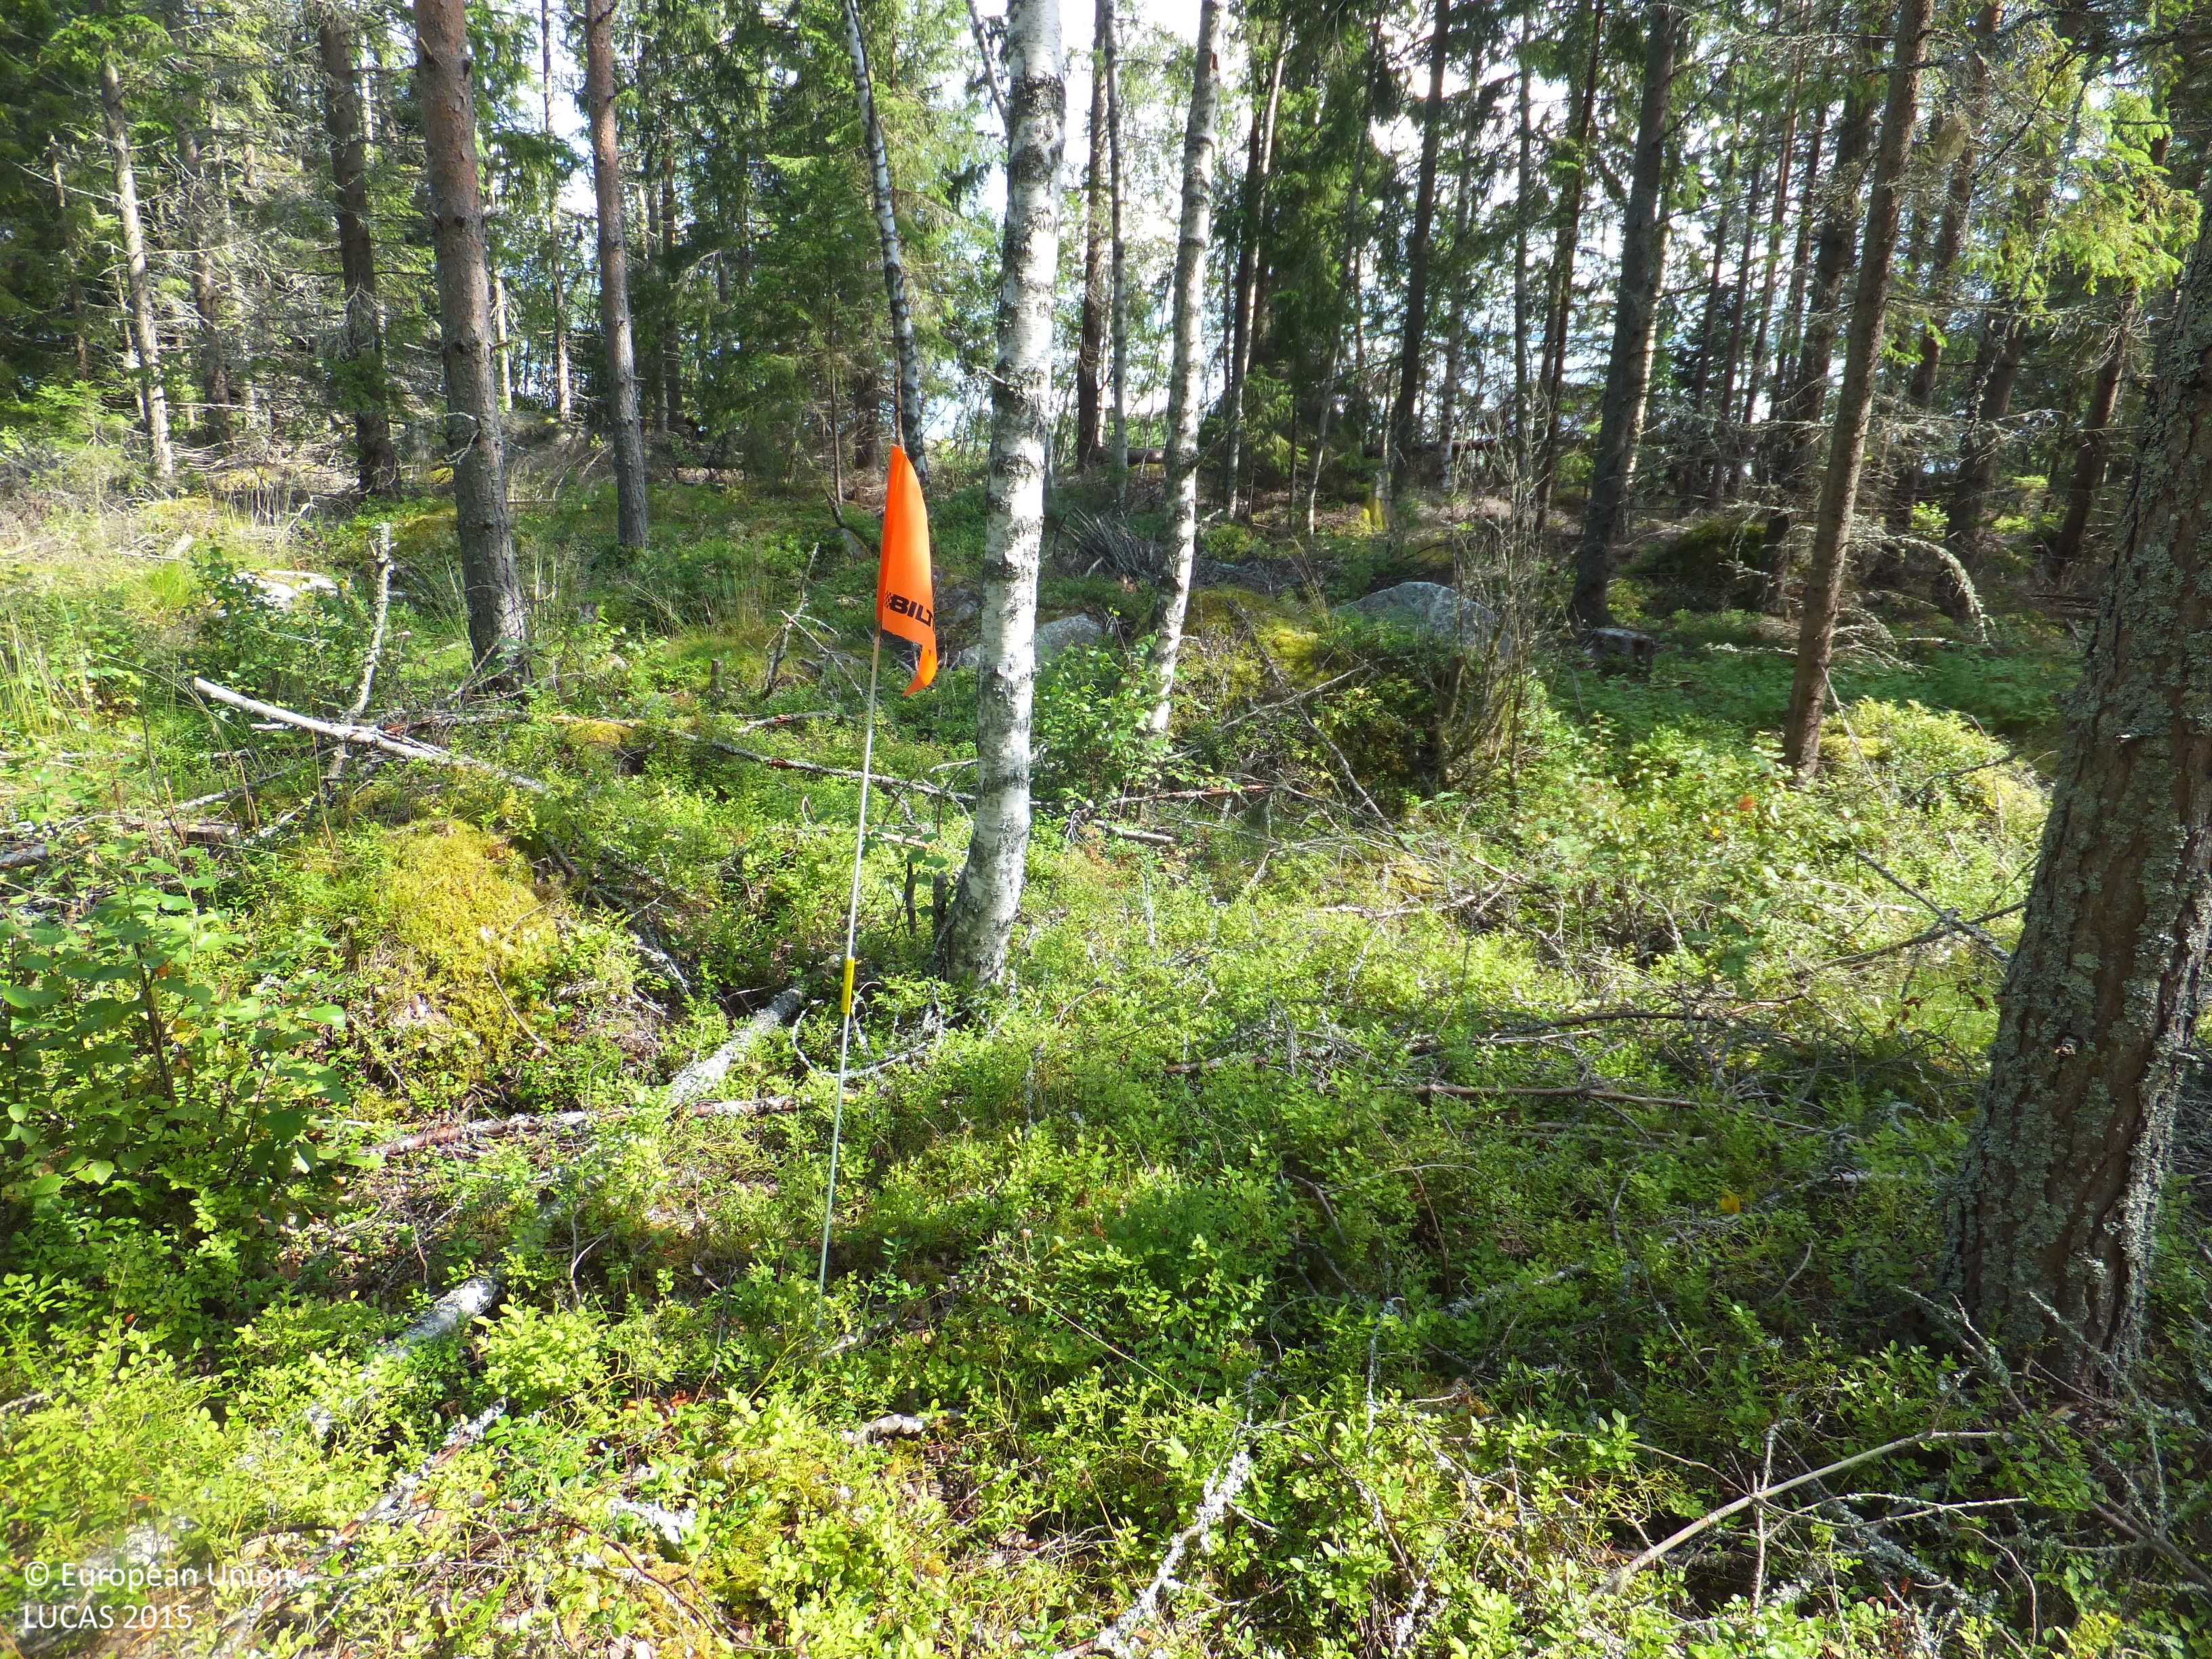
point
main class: Woodland
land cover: Other mixed woodland
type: boreal forest
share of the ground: 50 - 75 %
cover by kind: coniferous forest trees 30 %, broadleaved forest trees 30 %, shrubs 20 %, lichens and mosses 10 %, herbaceous plants 5 %, consolidated bare surface 5 %
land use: Forestry
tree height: > 5 m
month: July
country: FI
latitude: 63.3514
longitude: 22.0534
